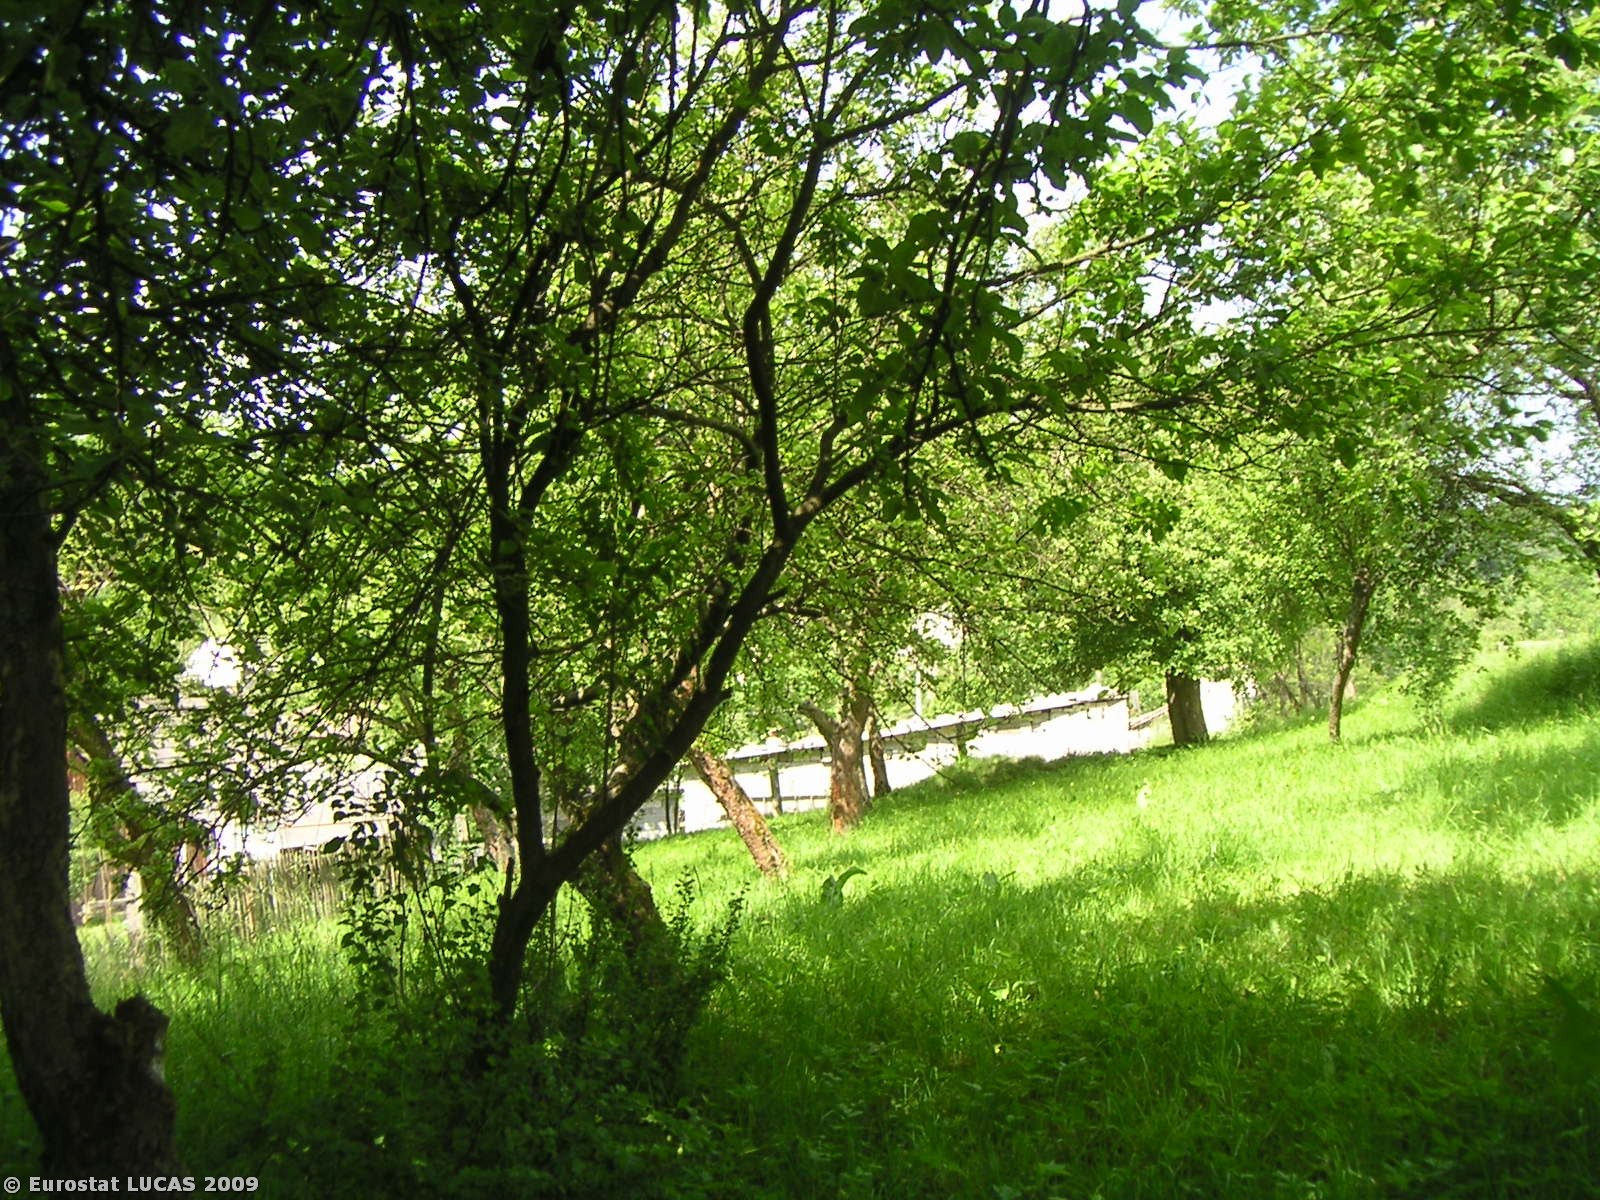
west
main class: Shrubland
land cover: Shrubland with sparse tree cover
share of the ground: > 75 %
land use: Unused
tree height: > 5 m
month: June
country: PL
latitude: 50.1881
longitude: 19.6792
